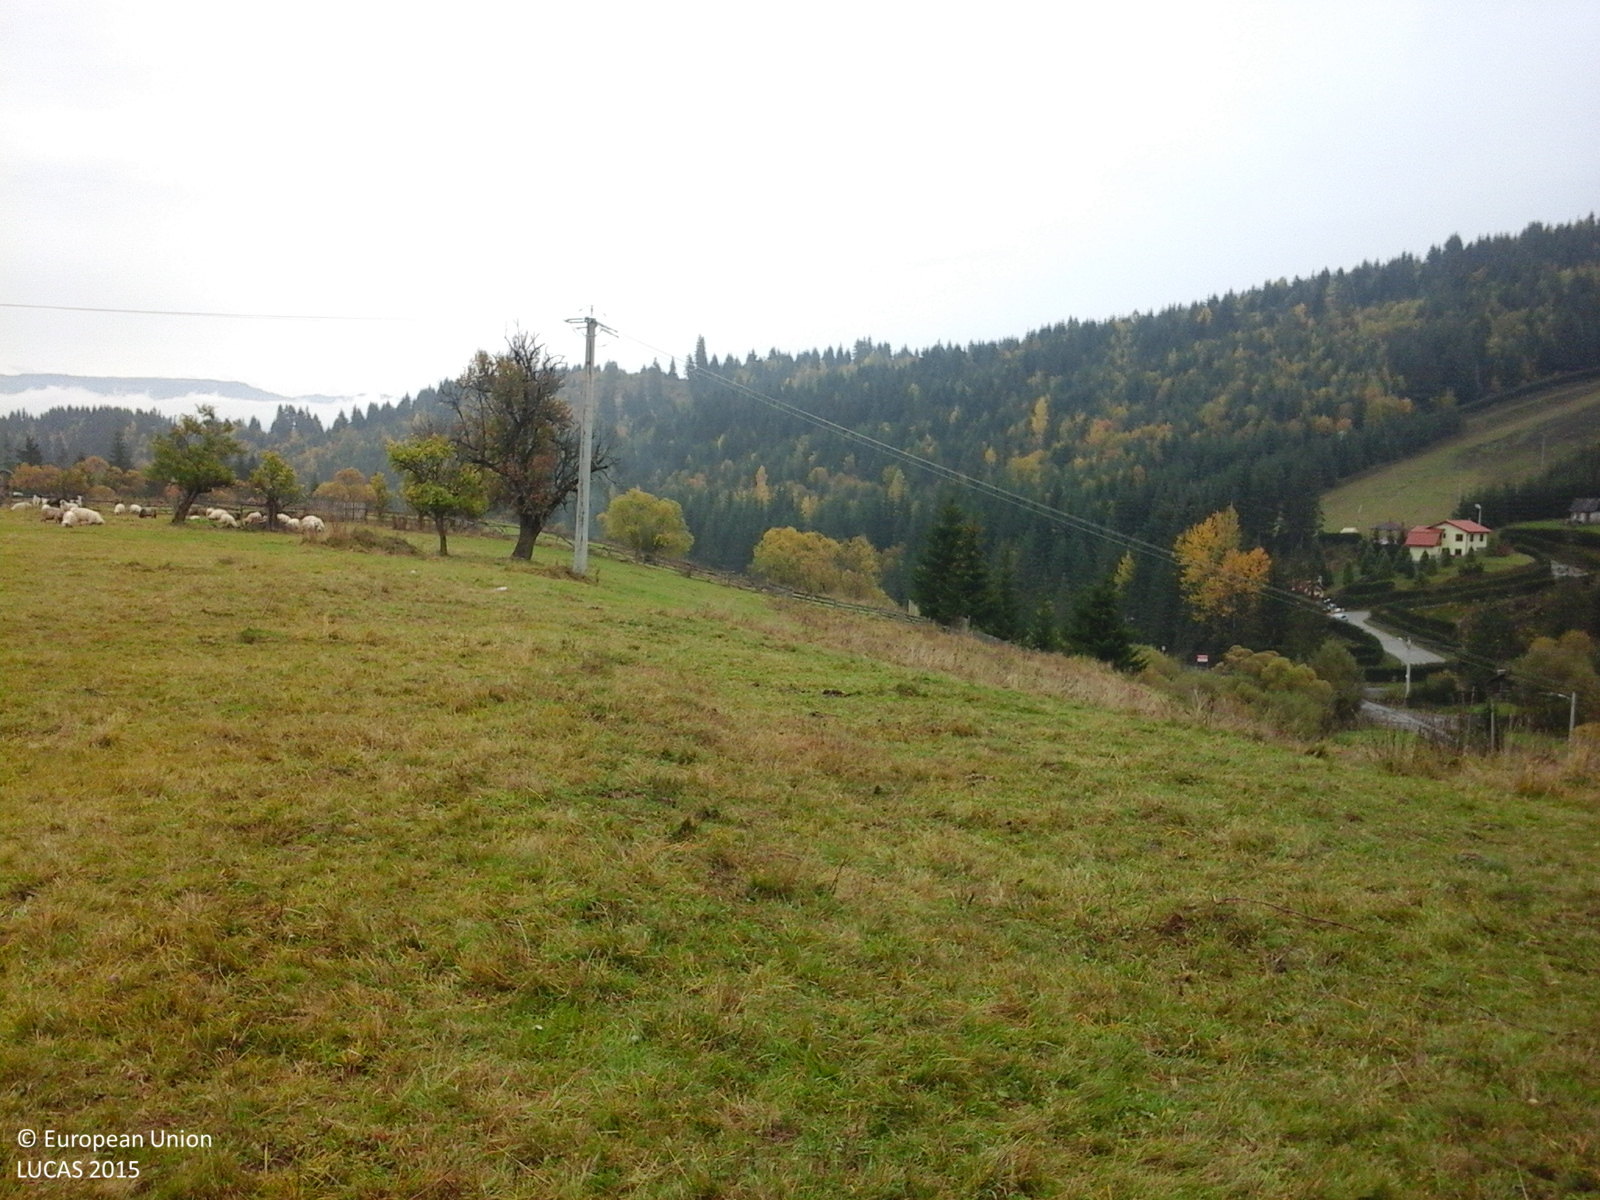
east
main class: Grassland
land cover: Grassland without tree/shrub cover
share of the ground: > 75 %
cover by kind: herbaceous plants 100 %
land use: Agriculture (excluding fallow land and kitchen gardens)
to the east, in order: Grassland without tree/shrub cover; Electric lines; Grassland without tree/shrub cover; Fences; Grassland without tree/shrub cover; Single bushes/trees; Grassland without tree/shrub cover; Grassland with sparse tree/shrub cover; Fences; Grassland with sparse tree/shrub cover
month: October
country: RO
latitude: 46.9059
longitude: 25.3232
